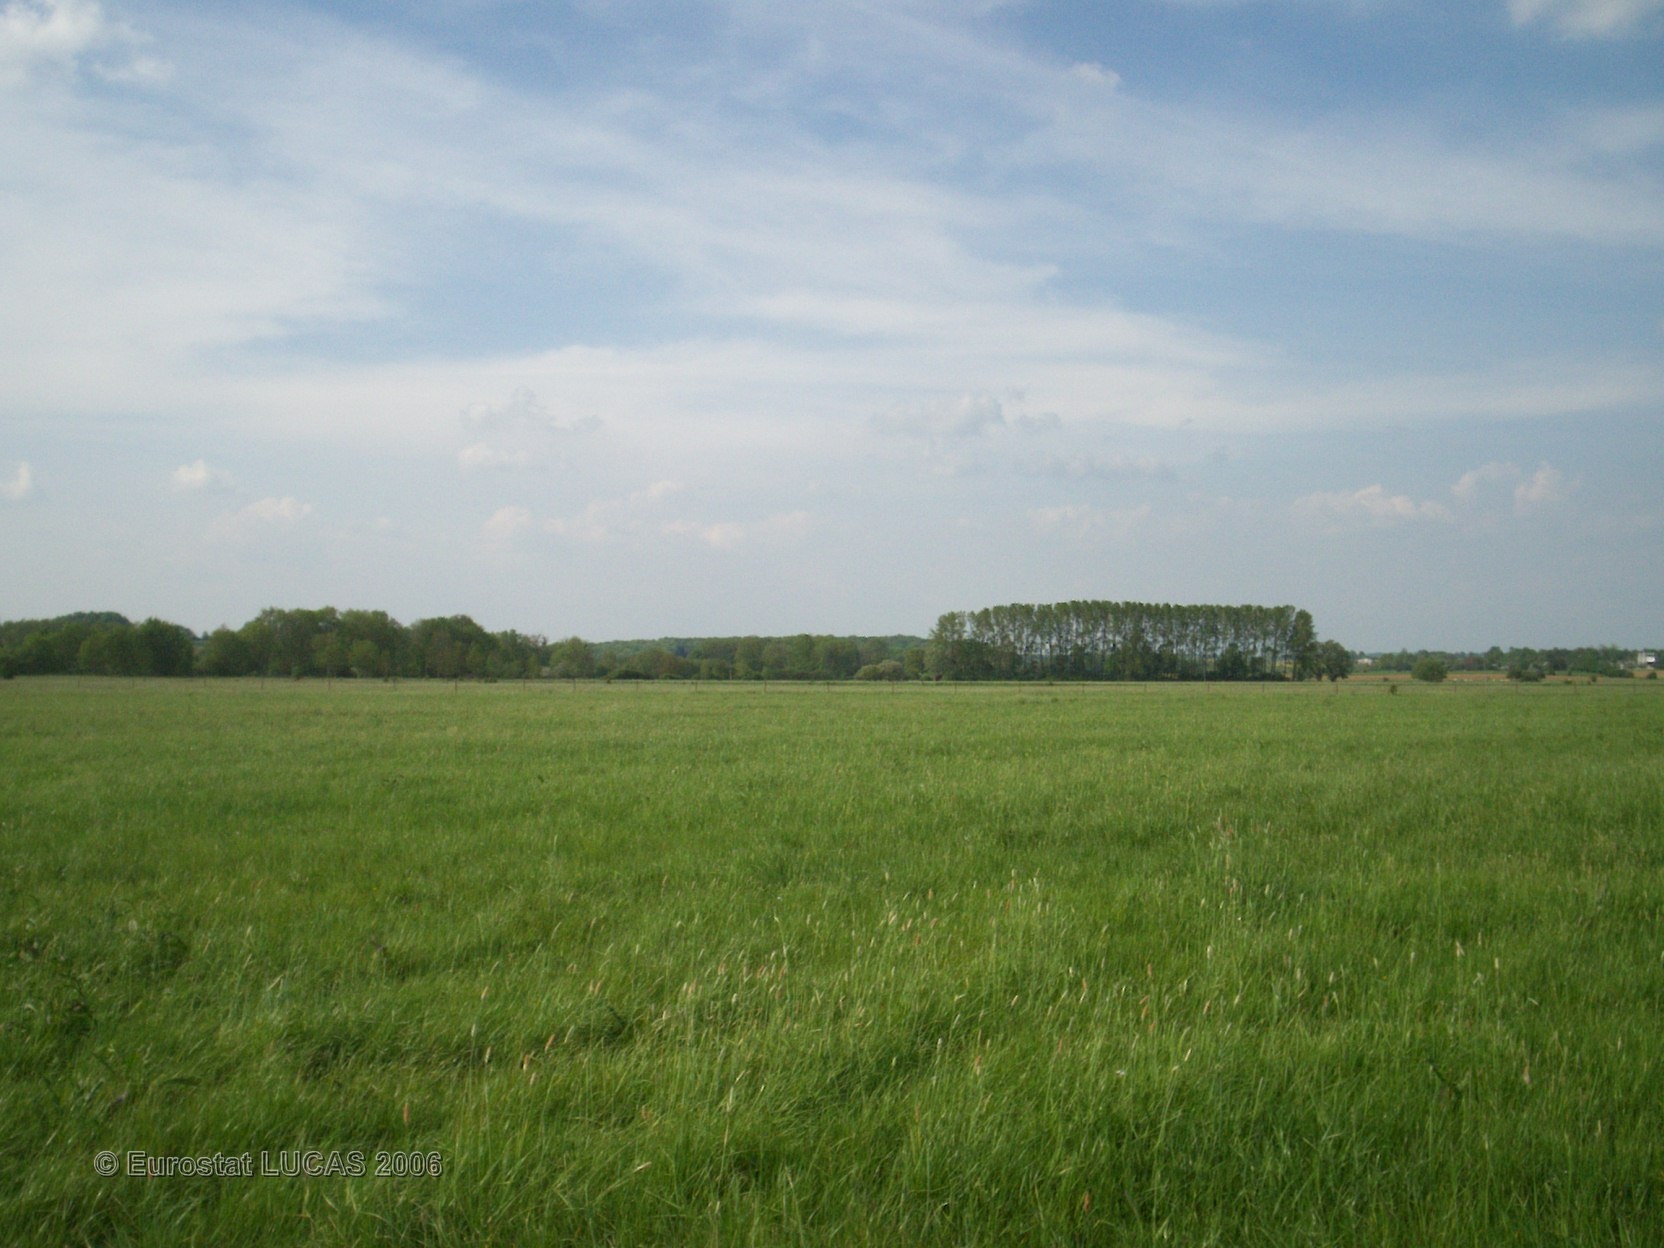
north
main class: Grassland
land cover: Grassland without tree/shrub cover
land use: Agriculture (excluding fallow land and kitchen gardens)
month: May
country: FR
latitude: 49.6108
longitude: 4.3354
